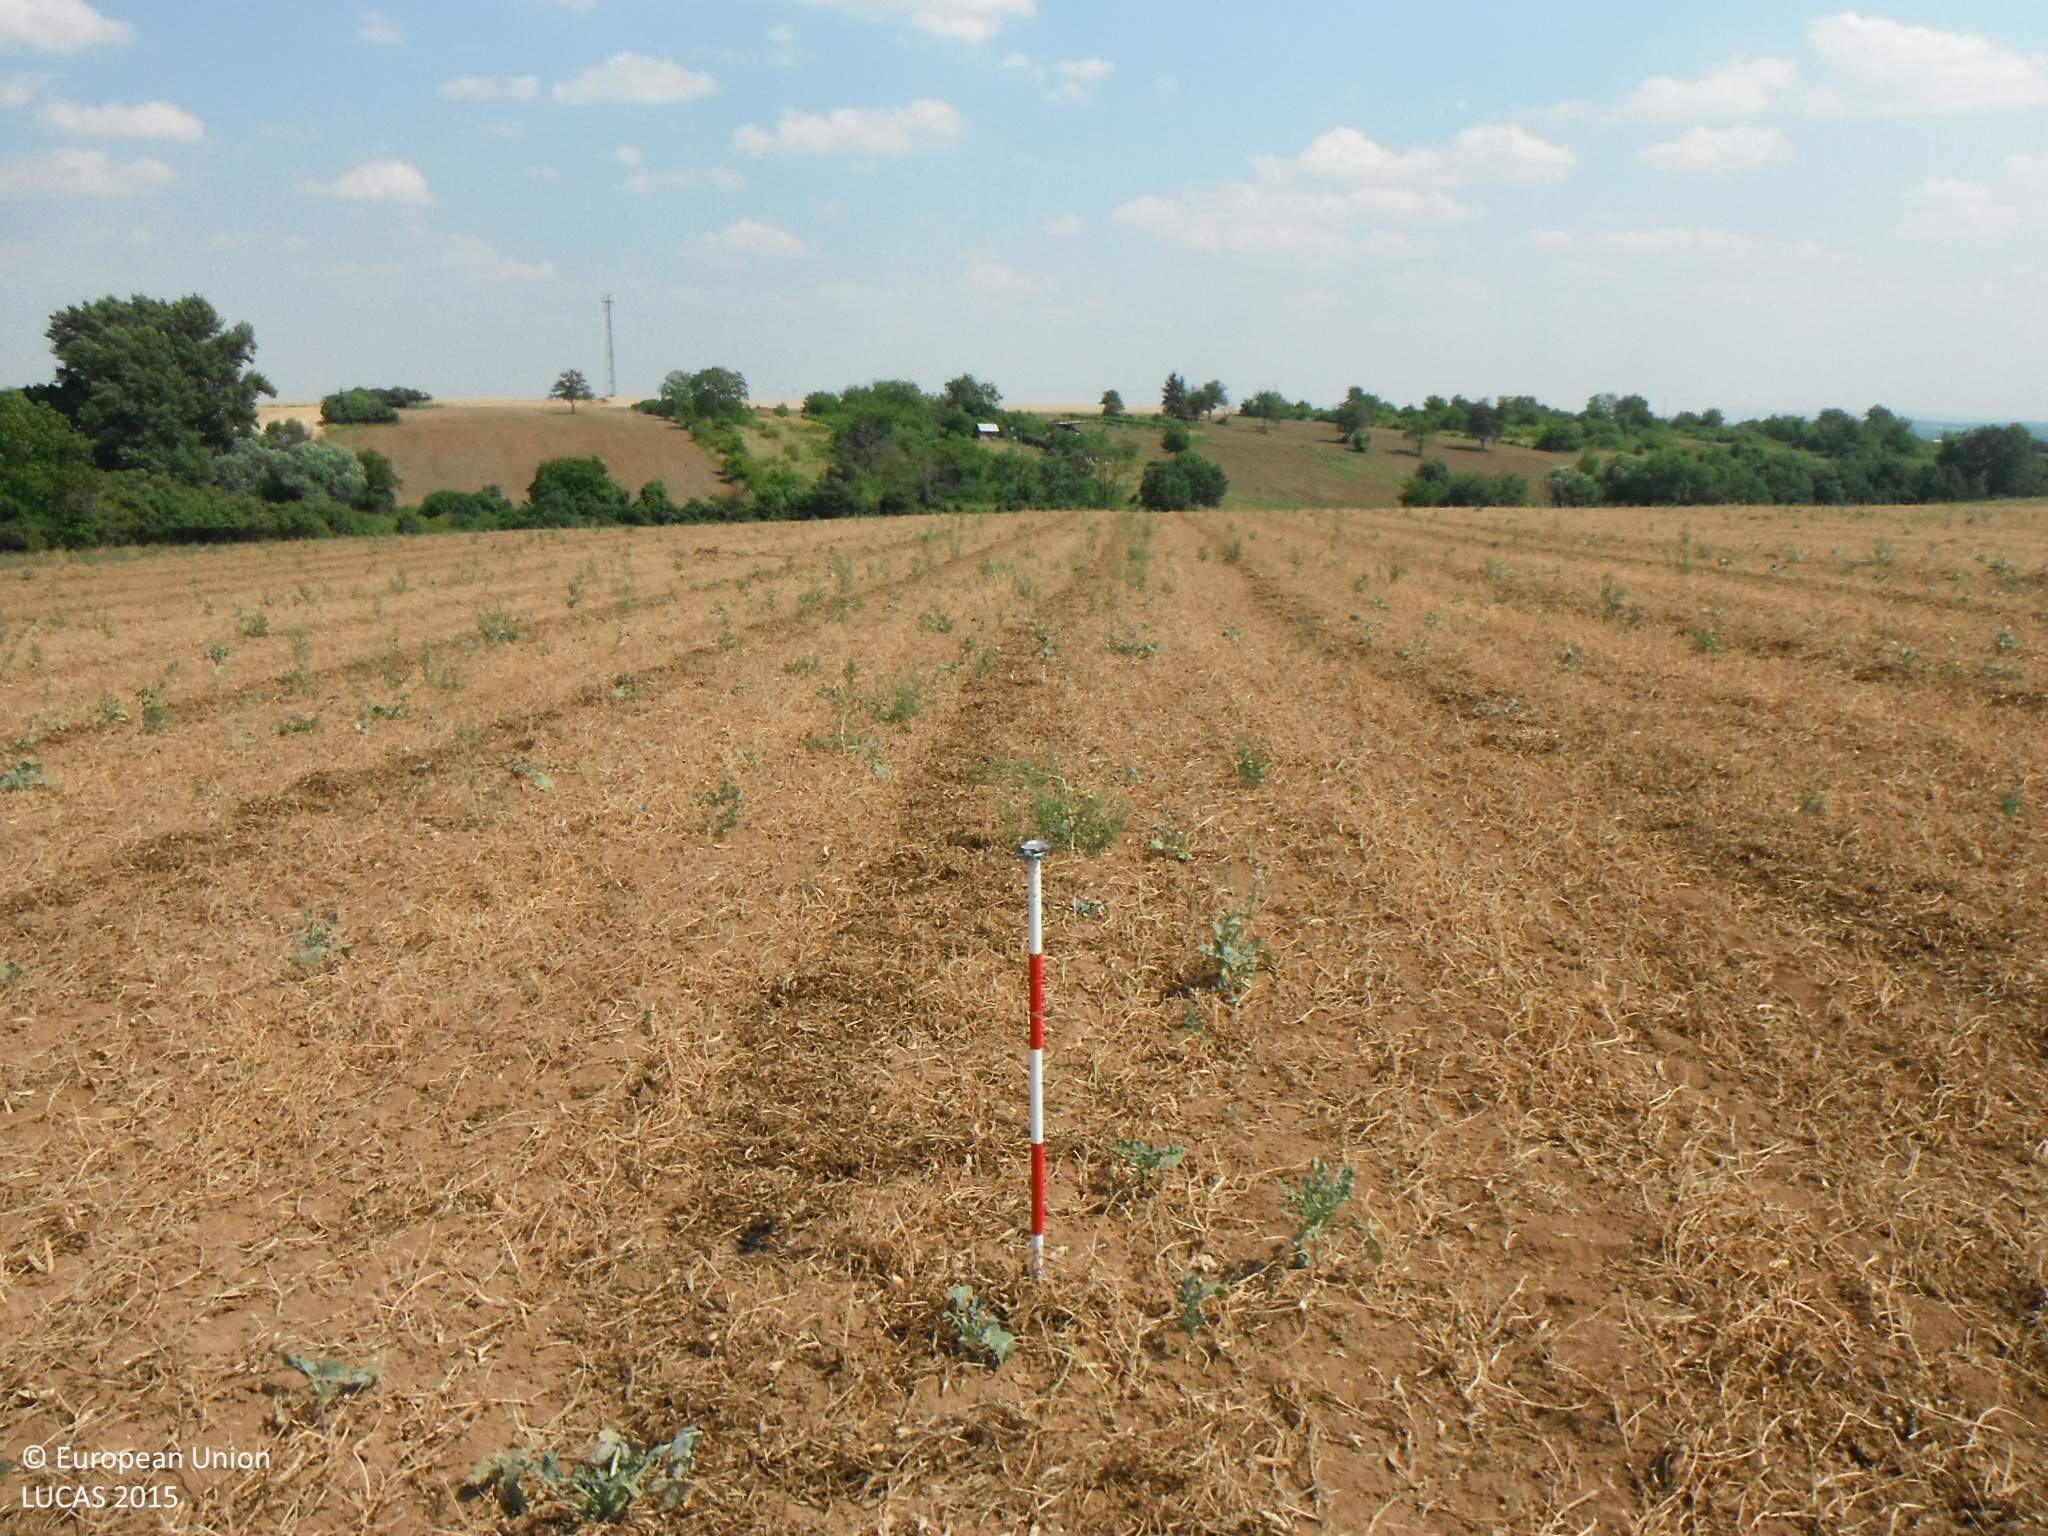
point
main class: Cropland
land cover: Dry pulses
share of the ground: > 75 %
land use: Agriculture (excluding fallow land and kitchen gardens)
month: July
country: SK
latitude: 48.0991
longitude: 19.1113
